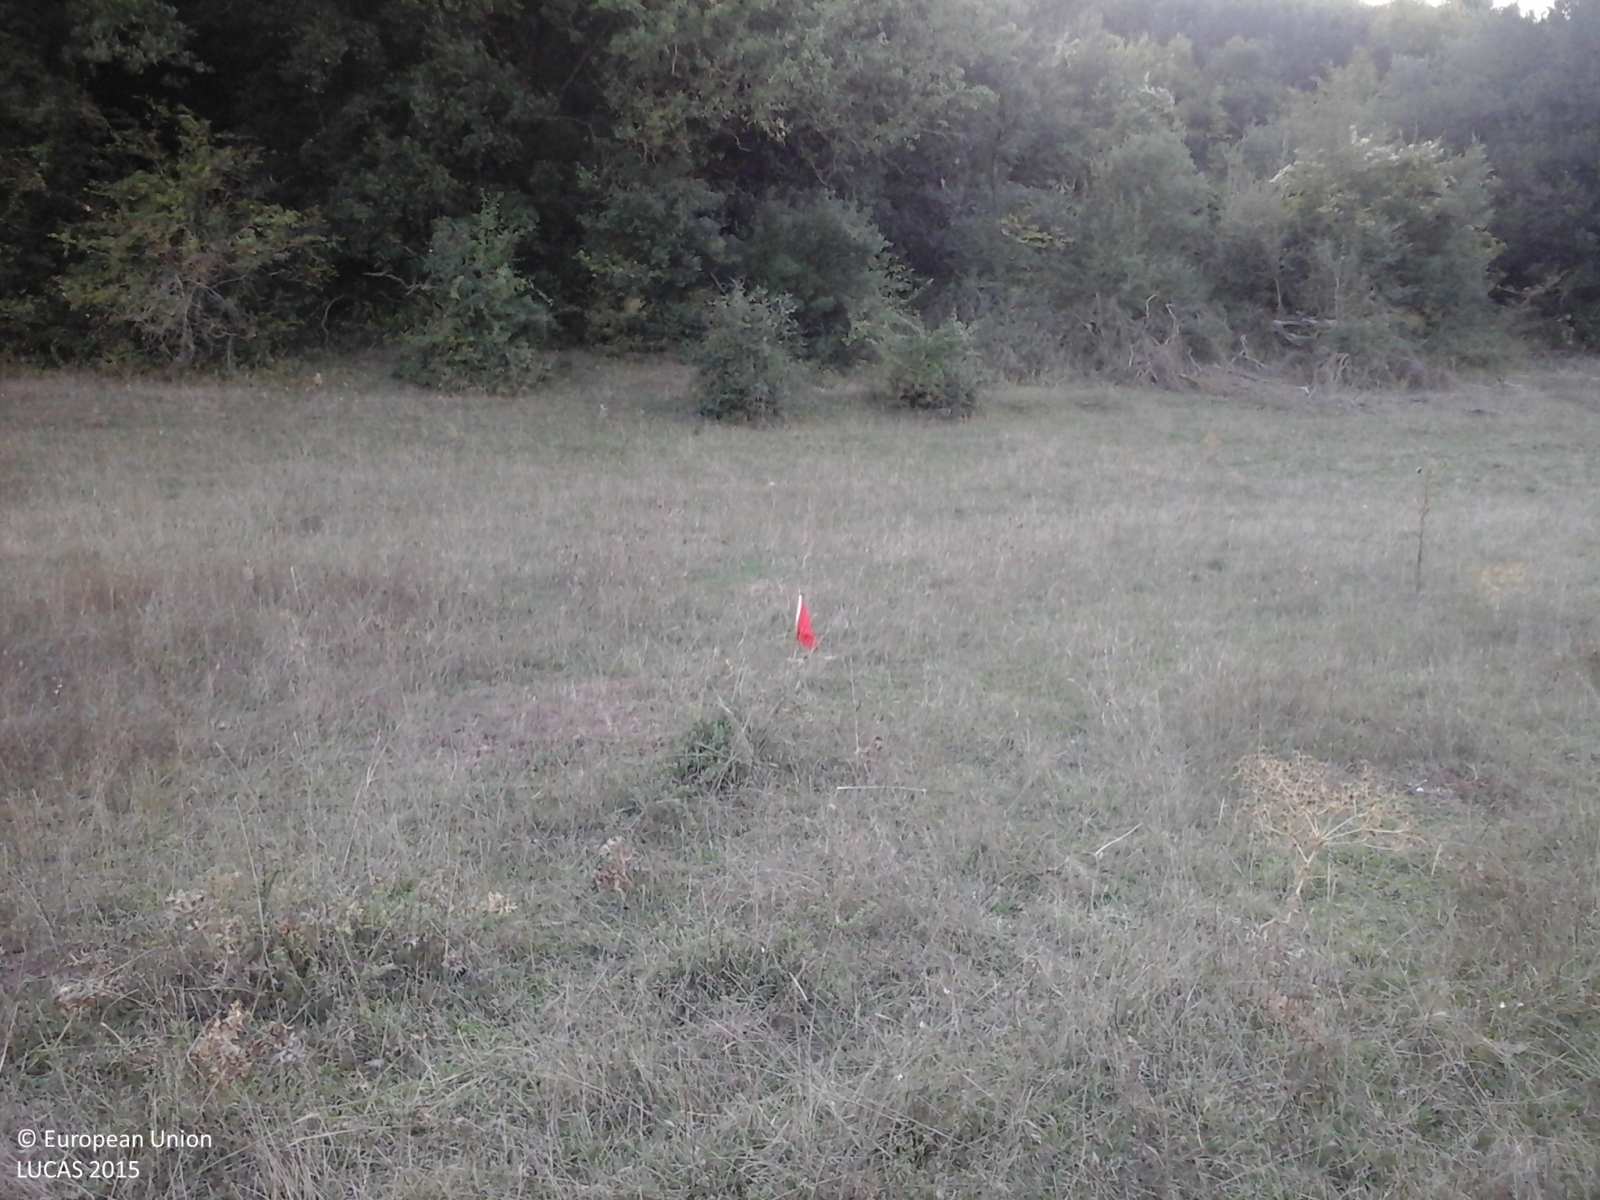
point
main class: Grassland
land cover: Spontaneously vegetated surfaces
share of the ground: > 75 %
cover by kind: herbaceous plants 100 %
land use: Agriculture (excluding fallow land and kitchen gardens)
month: September
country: GR
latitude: 39.8475
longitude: 20.6732
